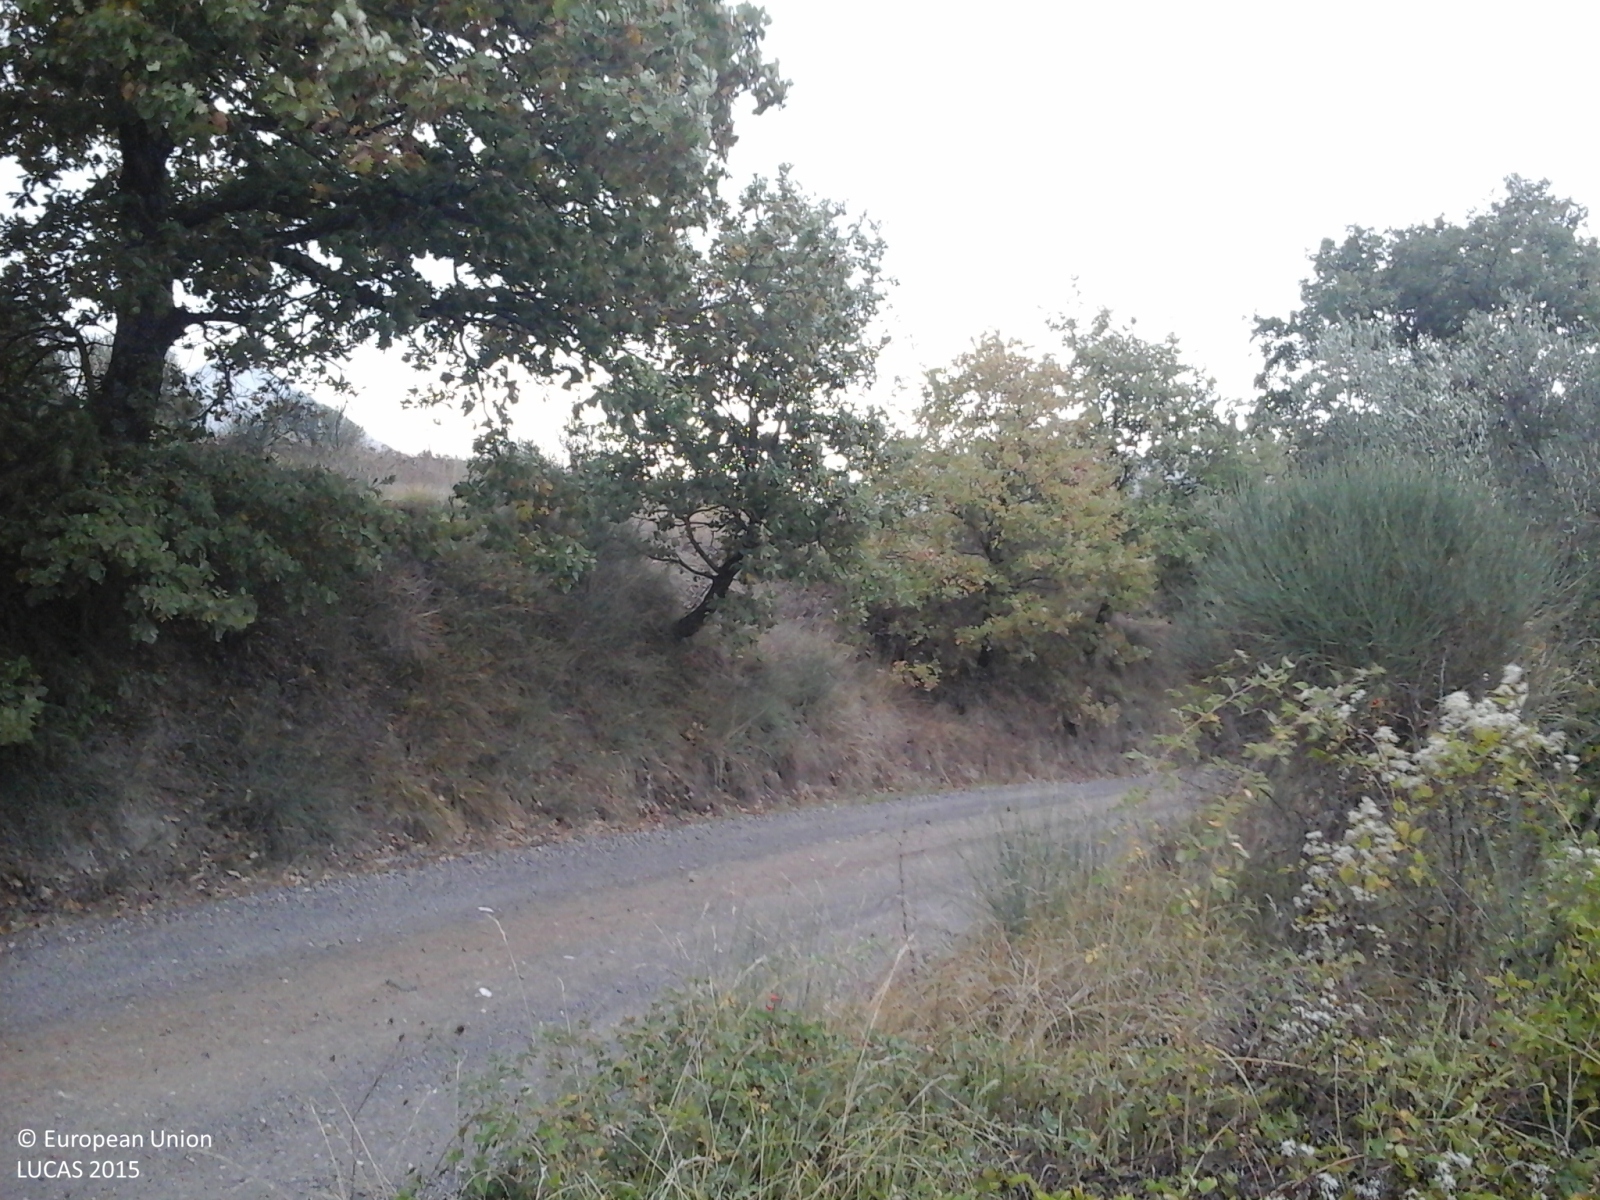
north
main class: Shrubland
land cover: Shrubland with sparse tree cover
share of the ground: > 75 %
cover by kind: shrubs 60 %, herbaceous plants 35 %, broadleaved forest trees 5 %
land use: Agriculture (excluding fallow land and kitchen gardens)
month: October
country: IT
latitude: 43.2235
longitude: 12.3203
